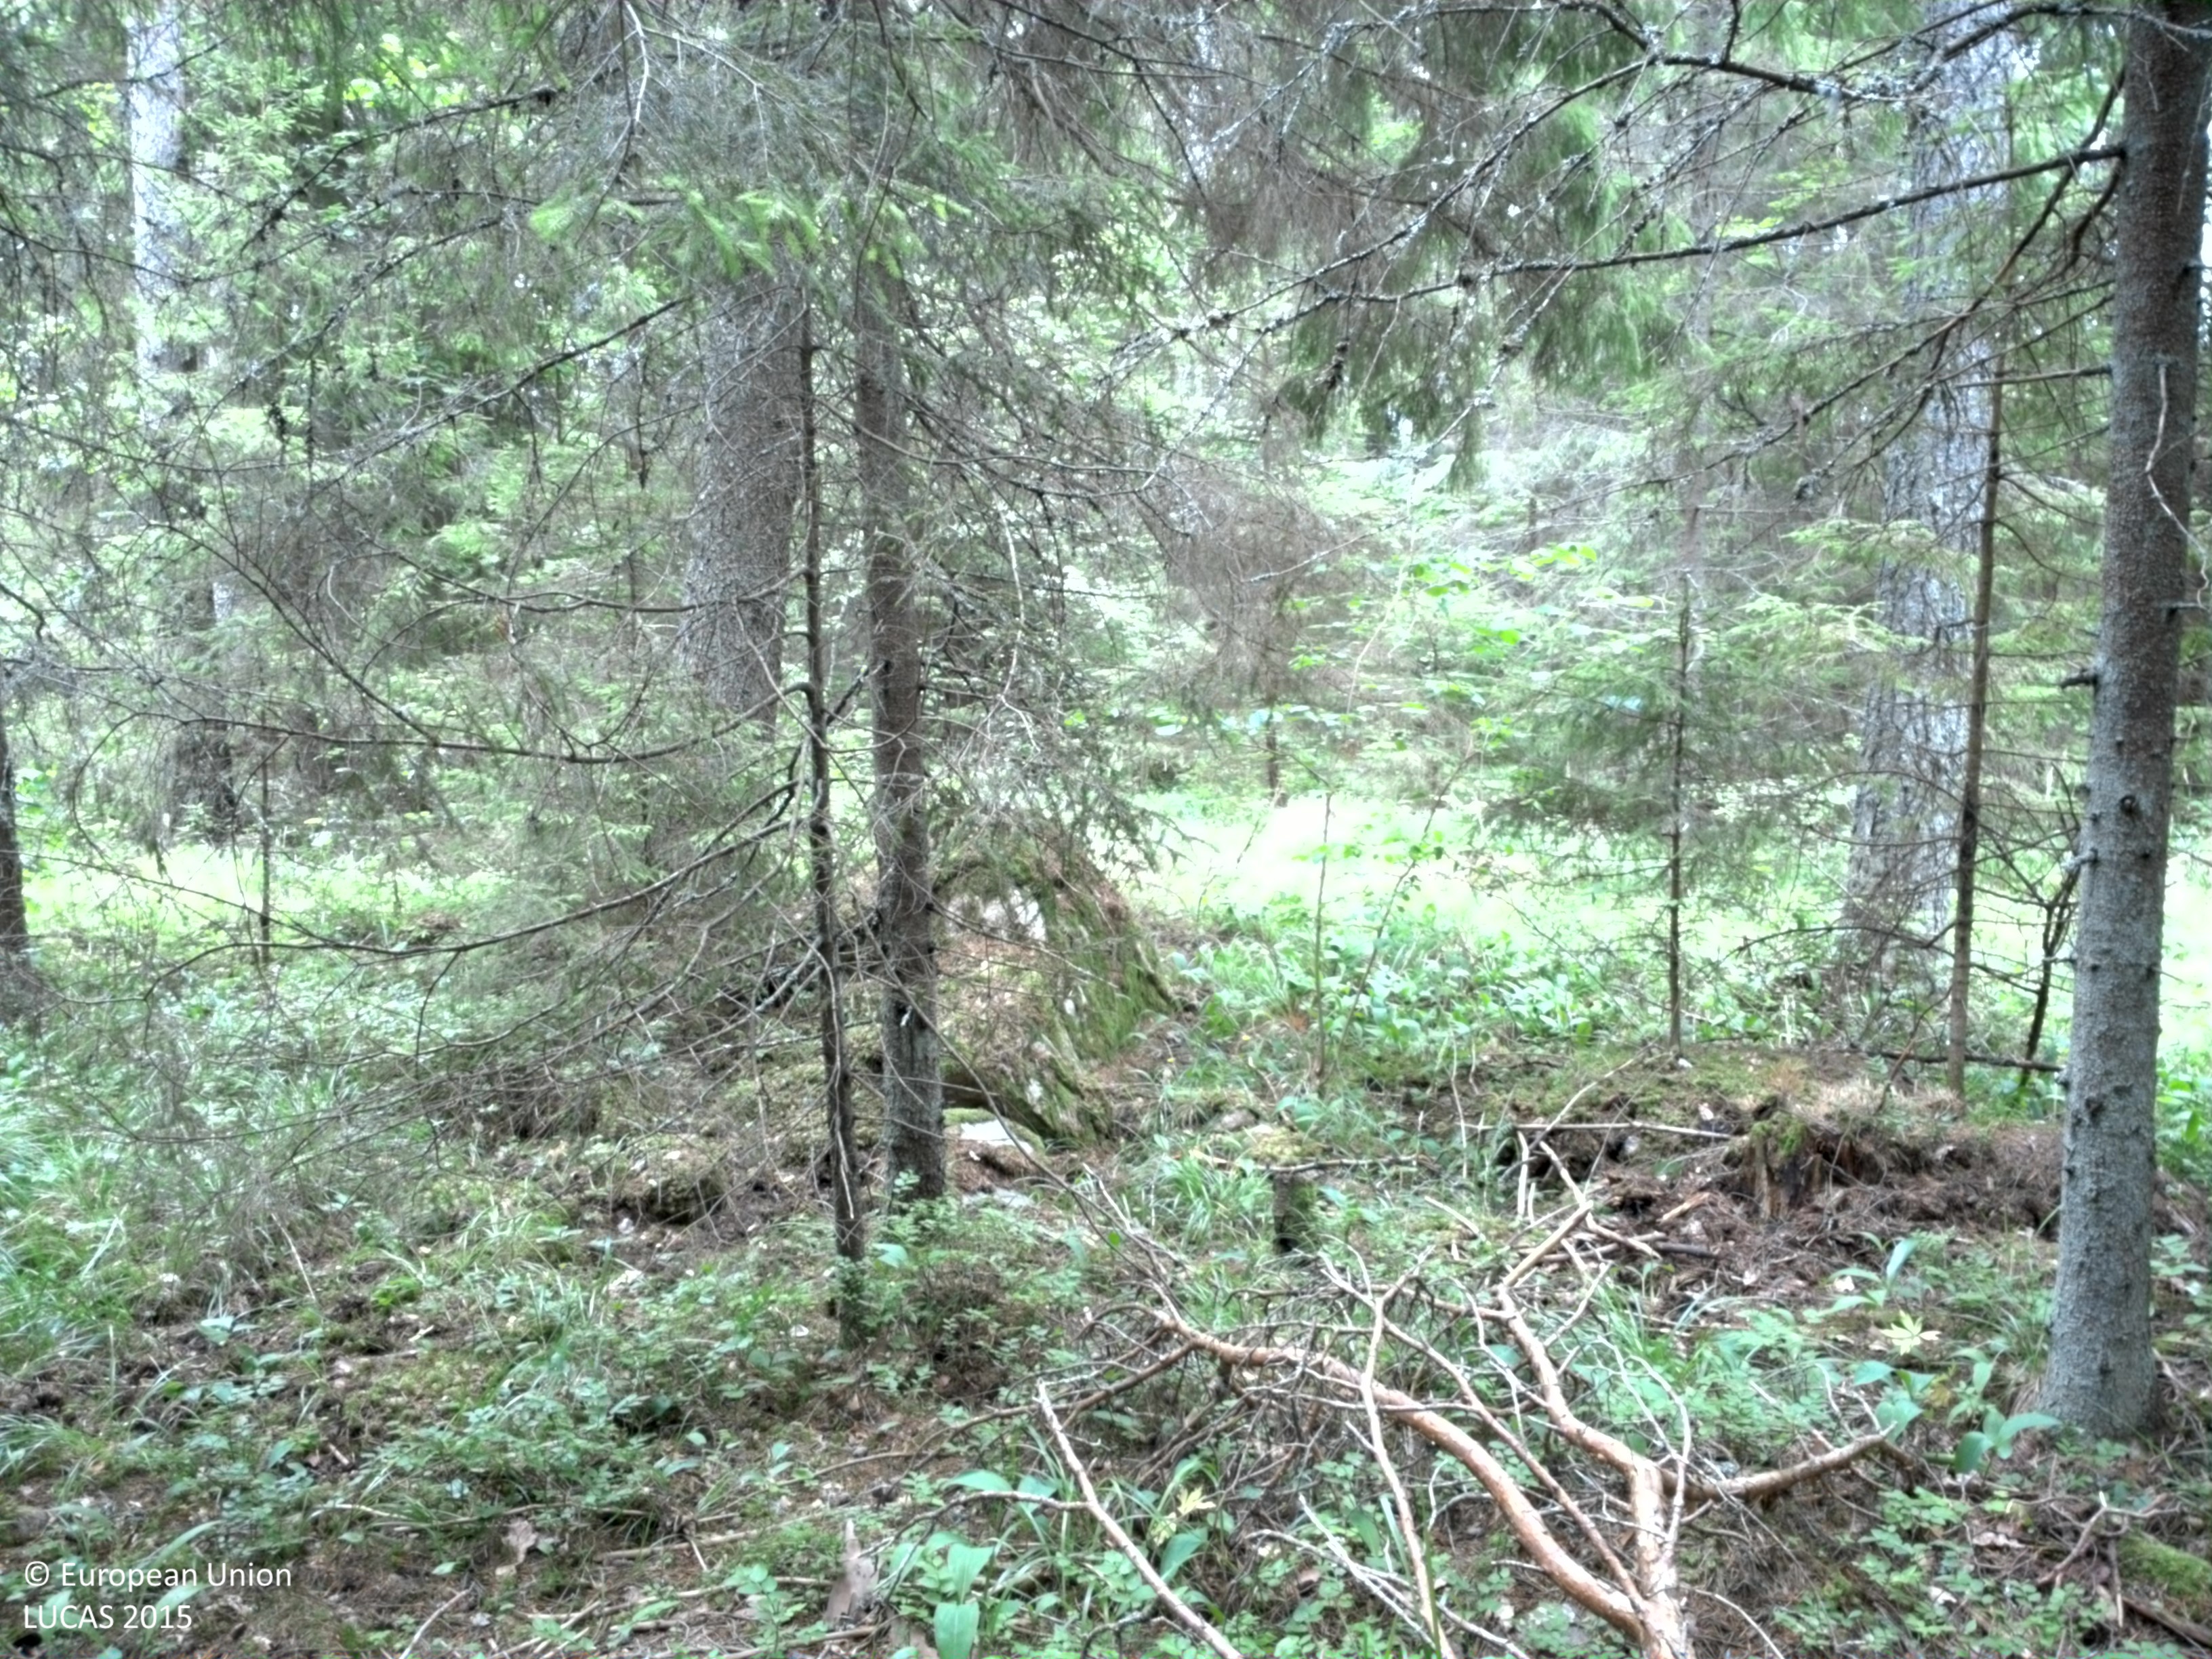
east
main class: Woodland
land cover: Spruce dominated coniferous woodland
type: boreal forest
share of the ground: > 75 %
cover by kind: coniferous forest trees 65 %, broadleaved forest trees 10 %, shrubs 10 %, herbaceous plants 10 %, lichens and mosses 5 %
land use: Forestry
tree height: > 5 m
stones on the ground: < 10 %
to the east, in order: Spruce dominated coniferous woodland; Spruce dominated mixed woodland; Tracks; Spruce dominated mixed woodland; Ditches and canals; Spruce dominated mixed woodland; Spruce dominated coniferous woodland; Spruce dominated mixed woodland; Spruce dominated coniferous woodland
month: July
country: SE
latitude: 59.8328
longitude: 18.5083
